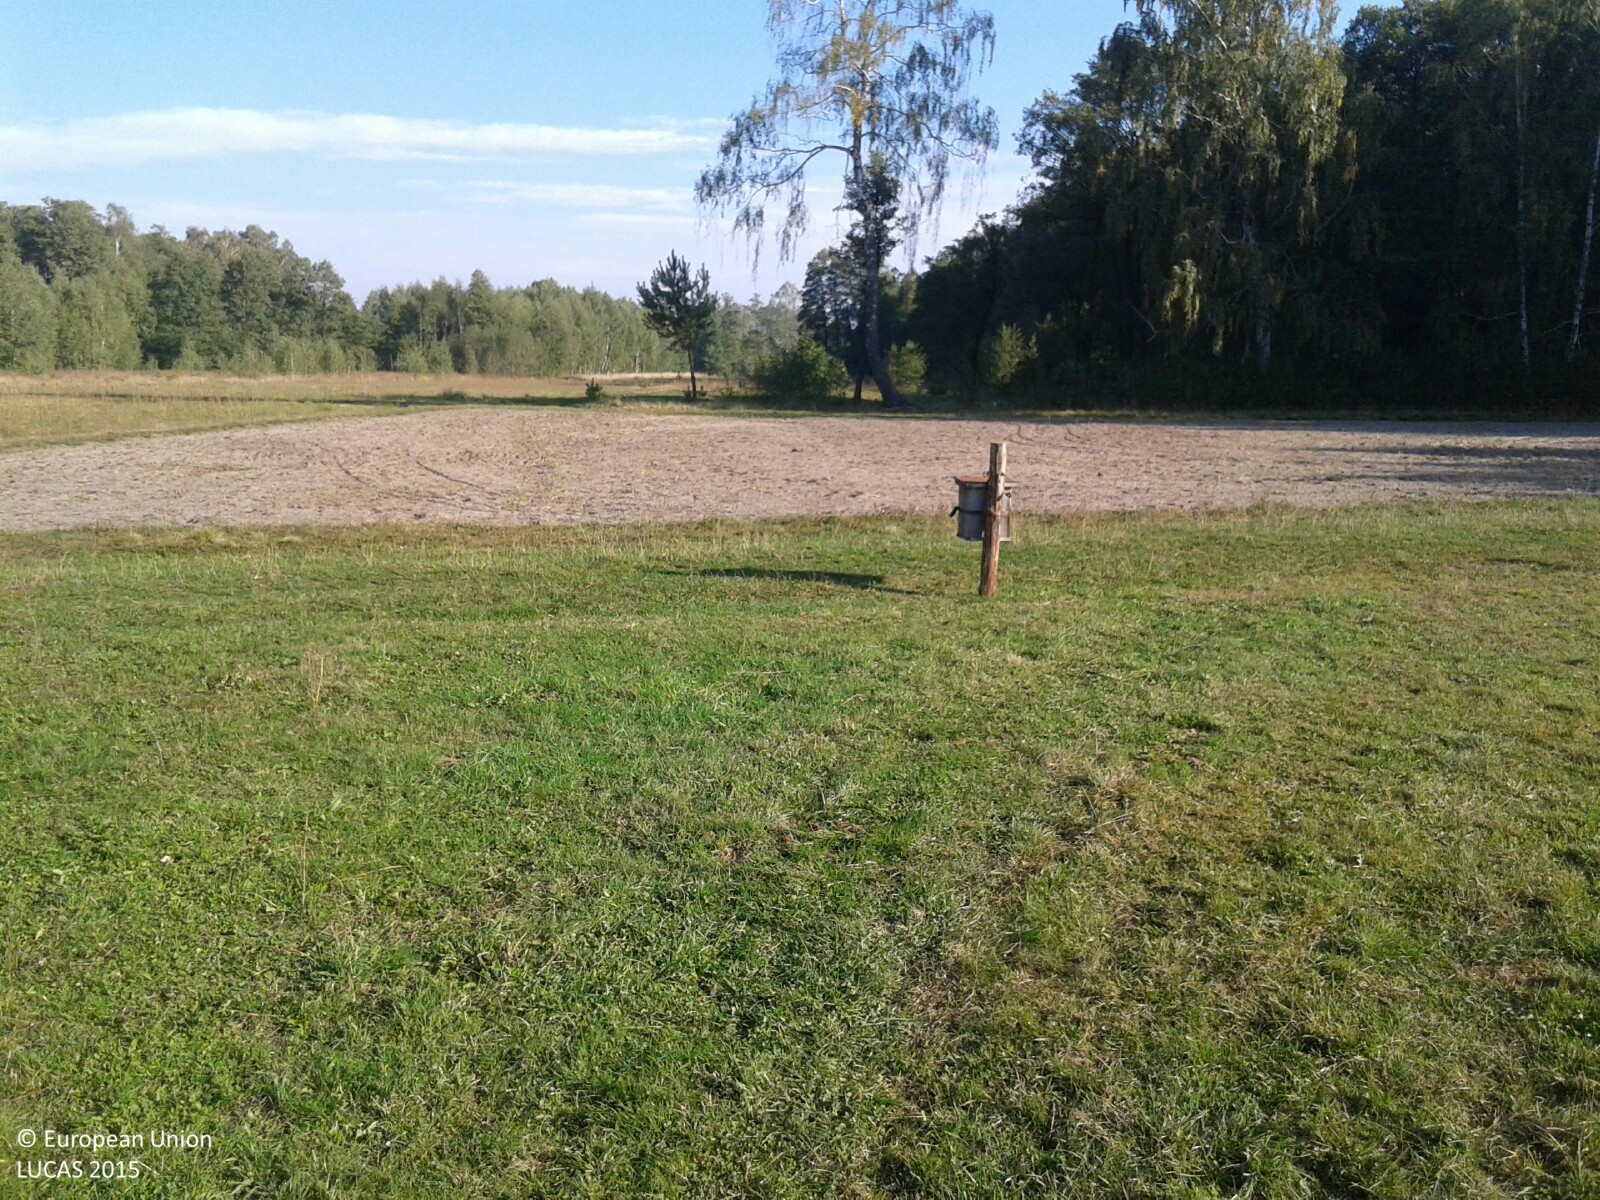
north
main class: Grassland
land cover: Grassland without tree/shrub cover
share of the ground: > 75 %
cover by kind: herbaceous plants 95 %, unconsolidated bare surface 5 %
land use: Agriculture (excluding fallow land and kitchen gardens)
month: September
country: PL
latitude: 52.6258
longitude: 21.9497
